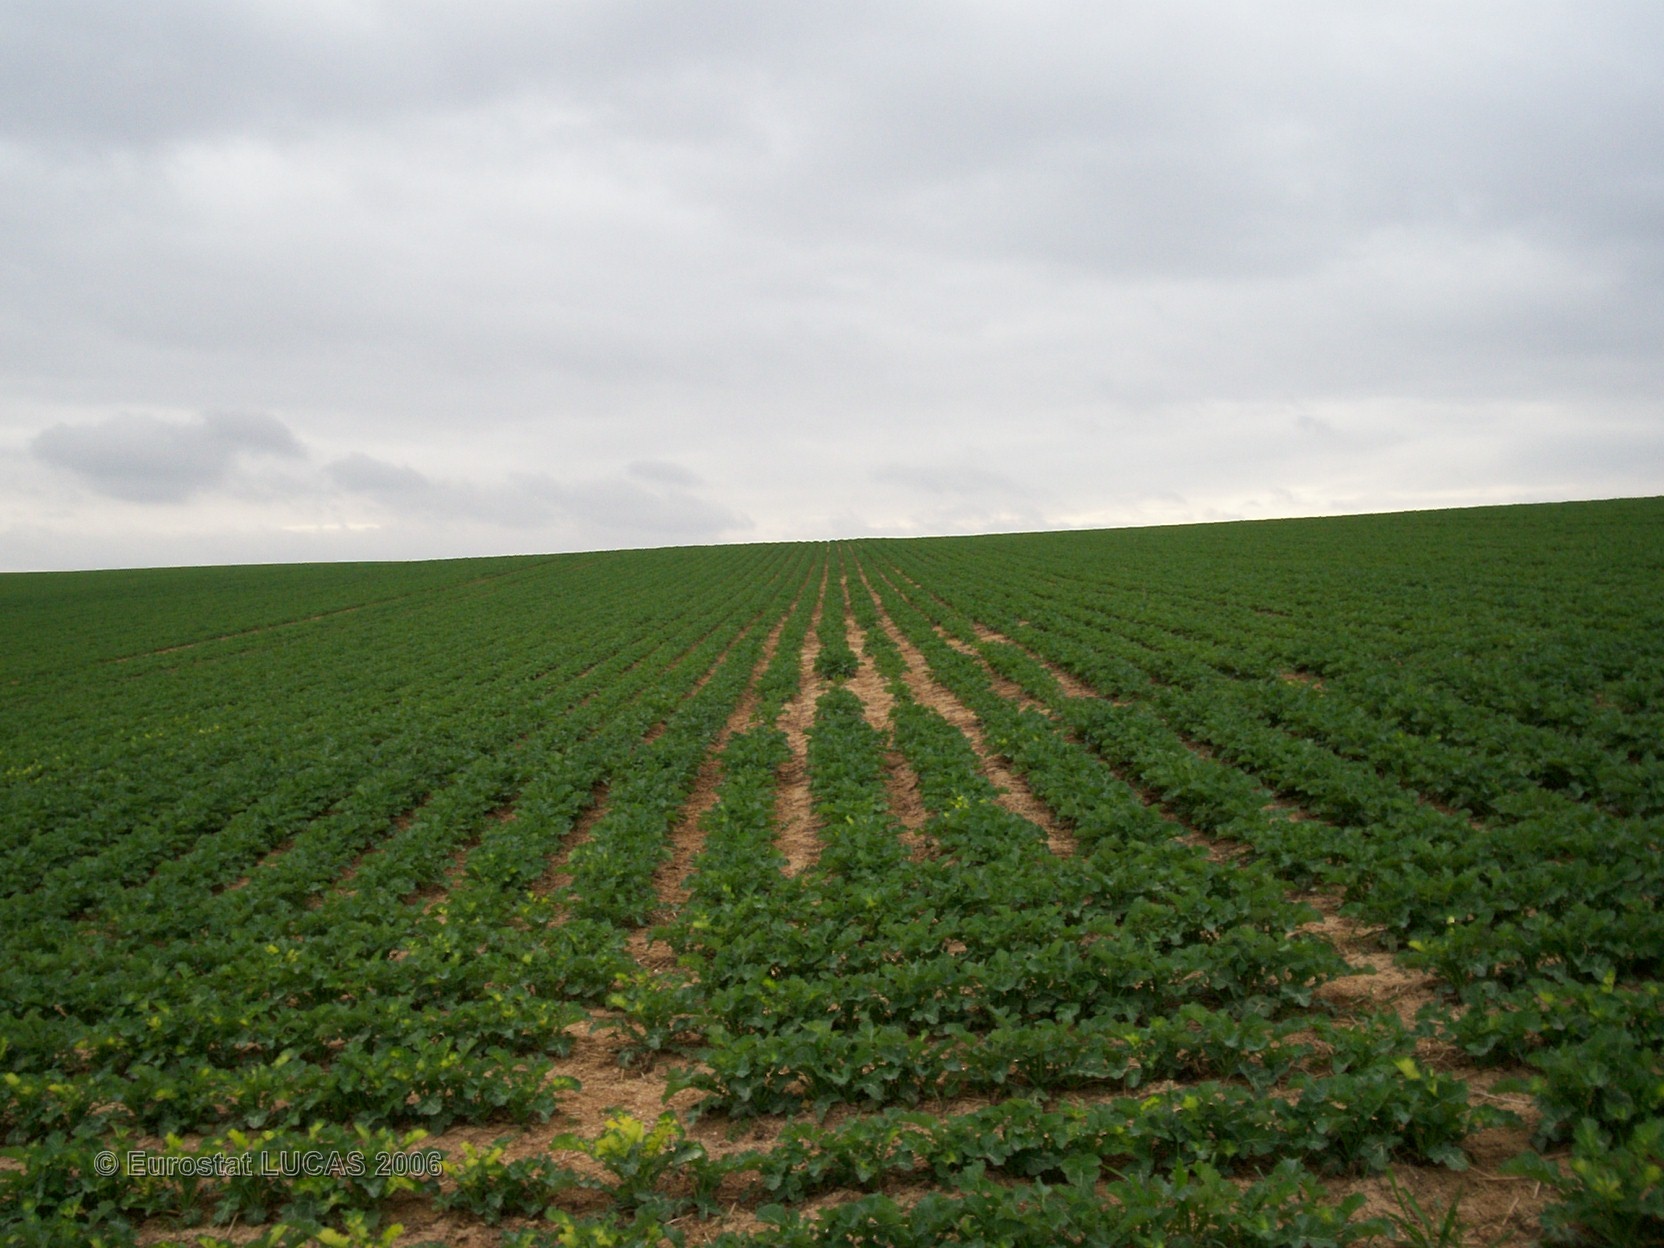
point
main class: Cropland
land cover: Rape and turnip rape
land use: Agriculture (excluding fallow land and kitchen gardens)
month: April
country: FR
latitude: 49.2205
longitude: 4.4633
